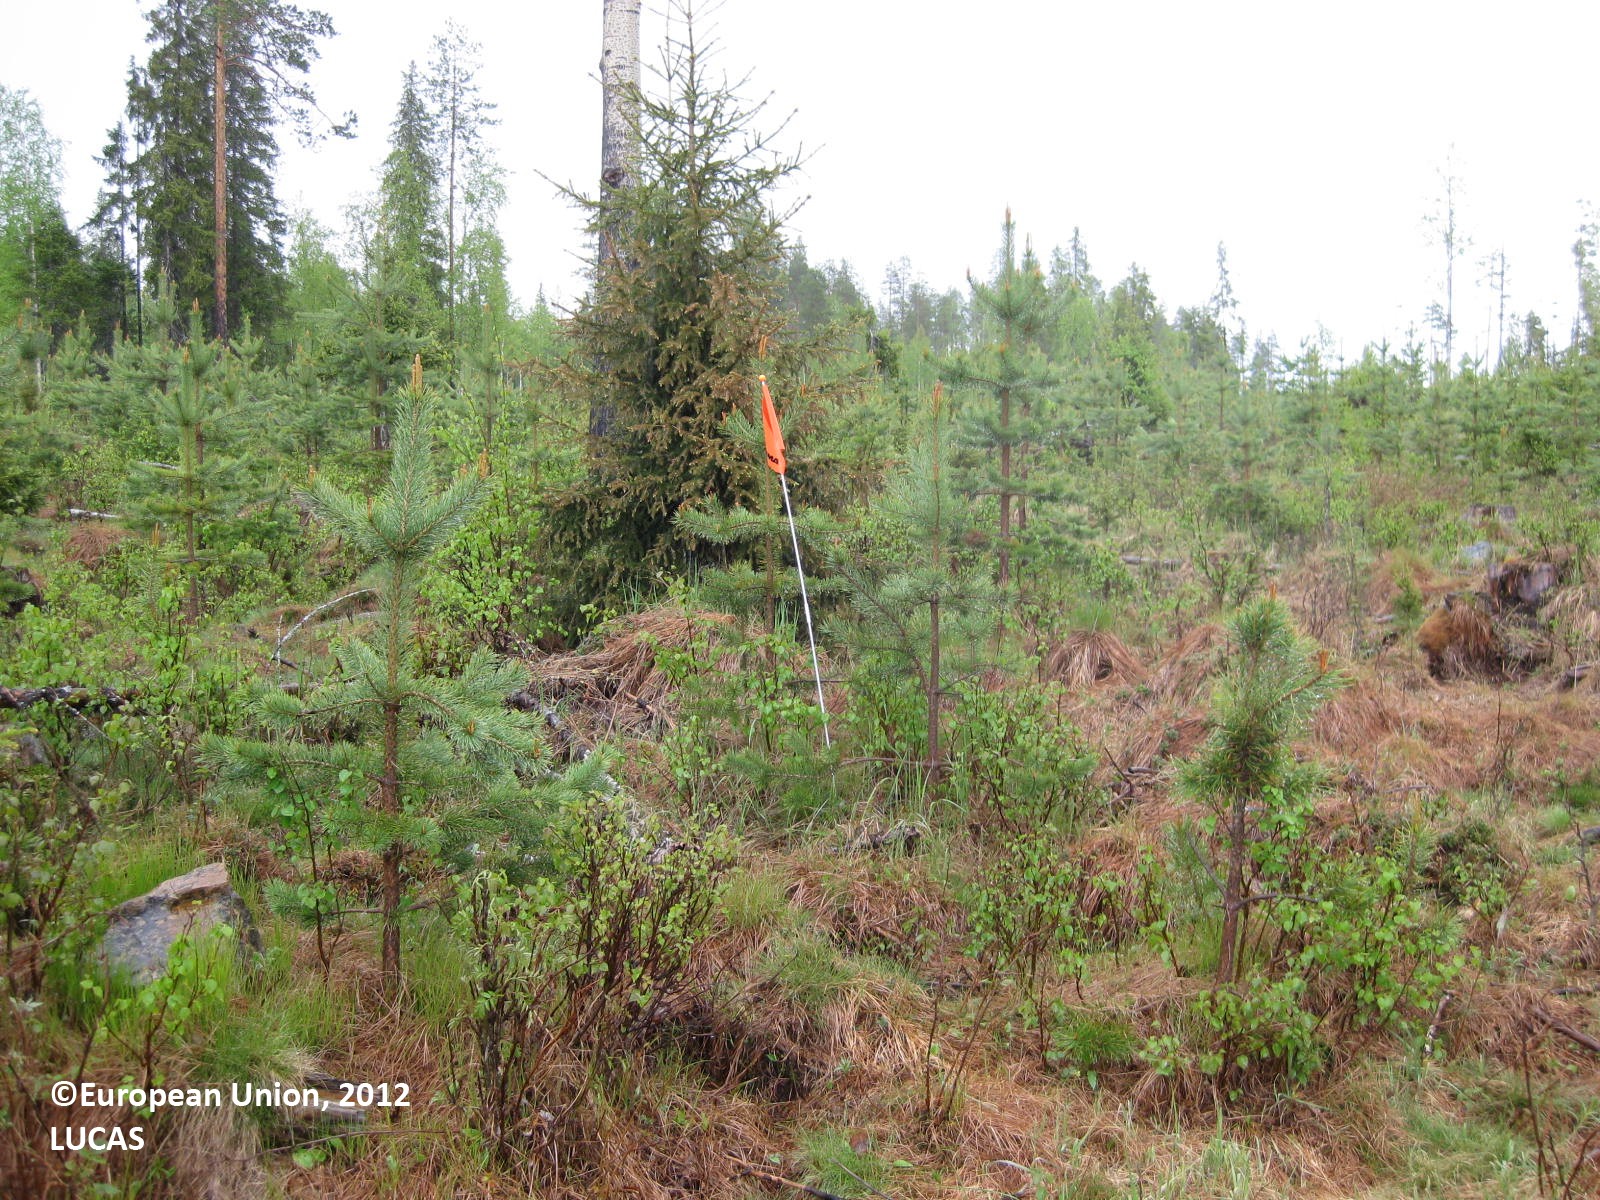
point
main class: Woodland
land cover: Pine dominated coniferous woodland
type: boreal forest
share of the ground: 50 - 75 %
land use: Forestry
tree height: < 5 m
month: June
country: FI
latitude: 65.1945
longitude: 29.4927
